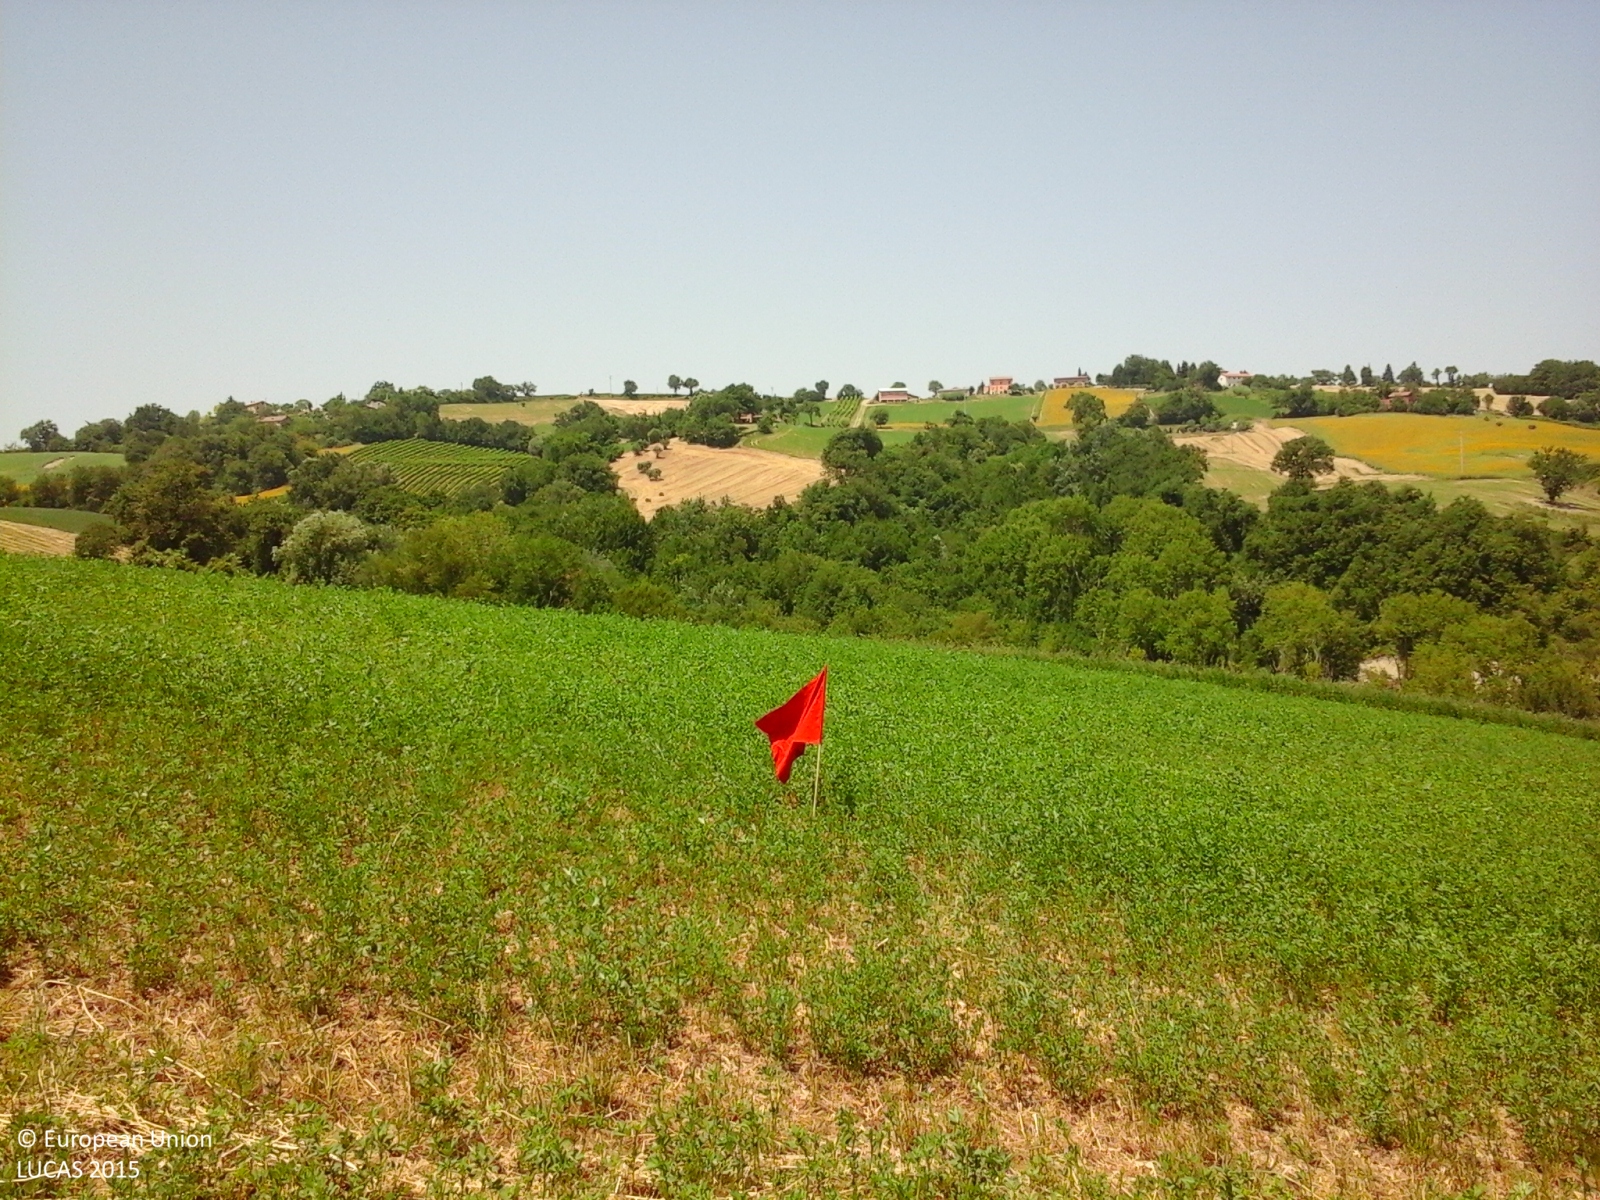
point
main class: Cropland
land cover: Lucerne
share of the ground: > 75 %
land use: Agriculture (excluding fallow land and kitchen gardens)
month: July
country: IT
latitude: 43.1220
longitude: 13.3710
